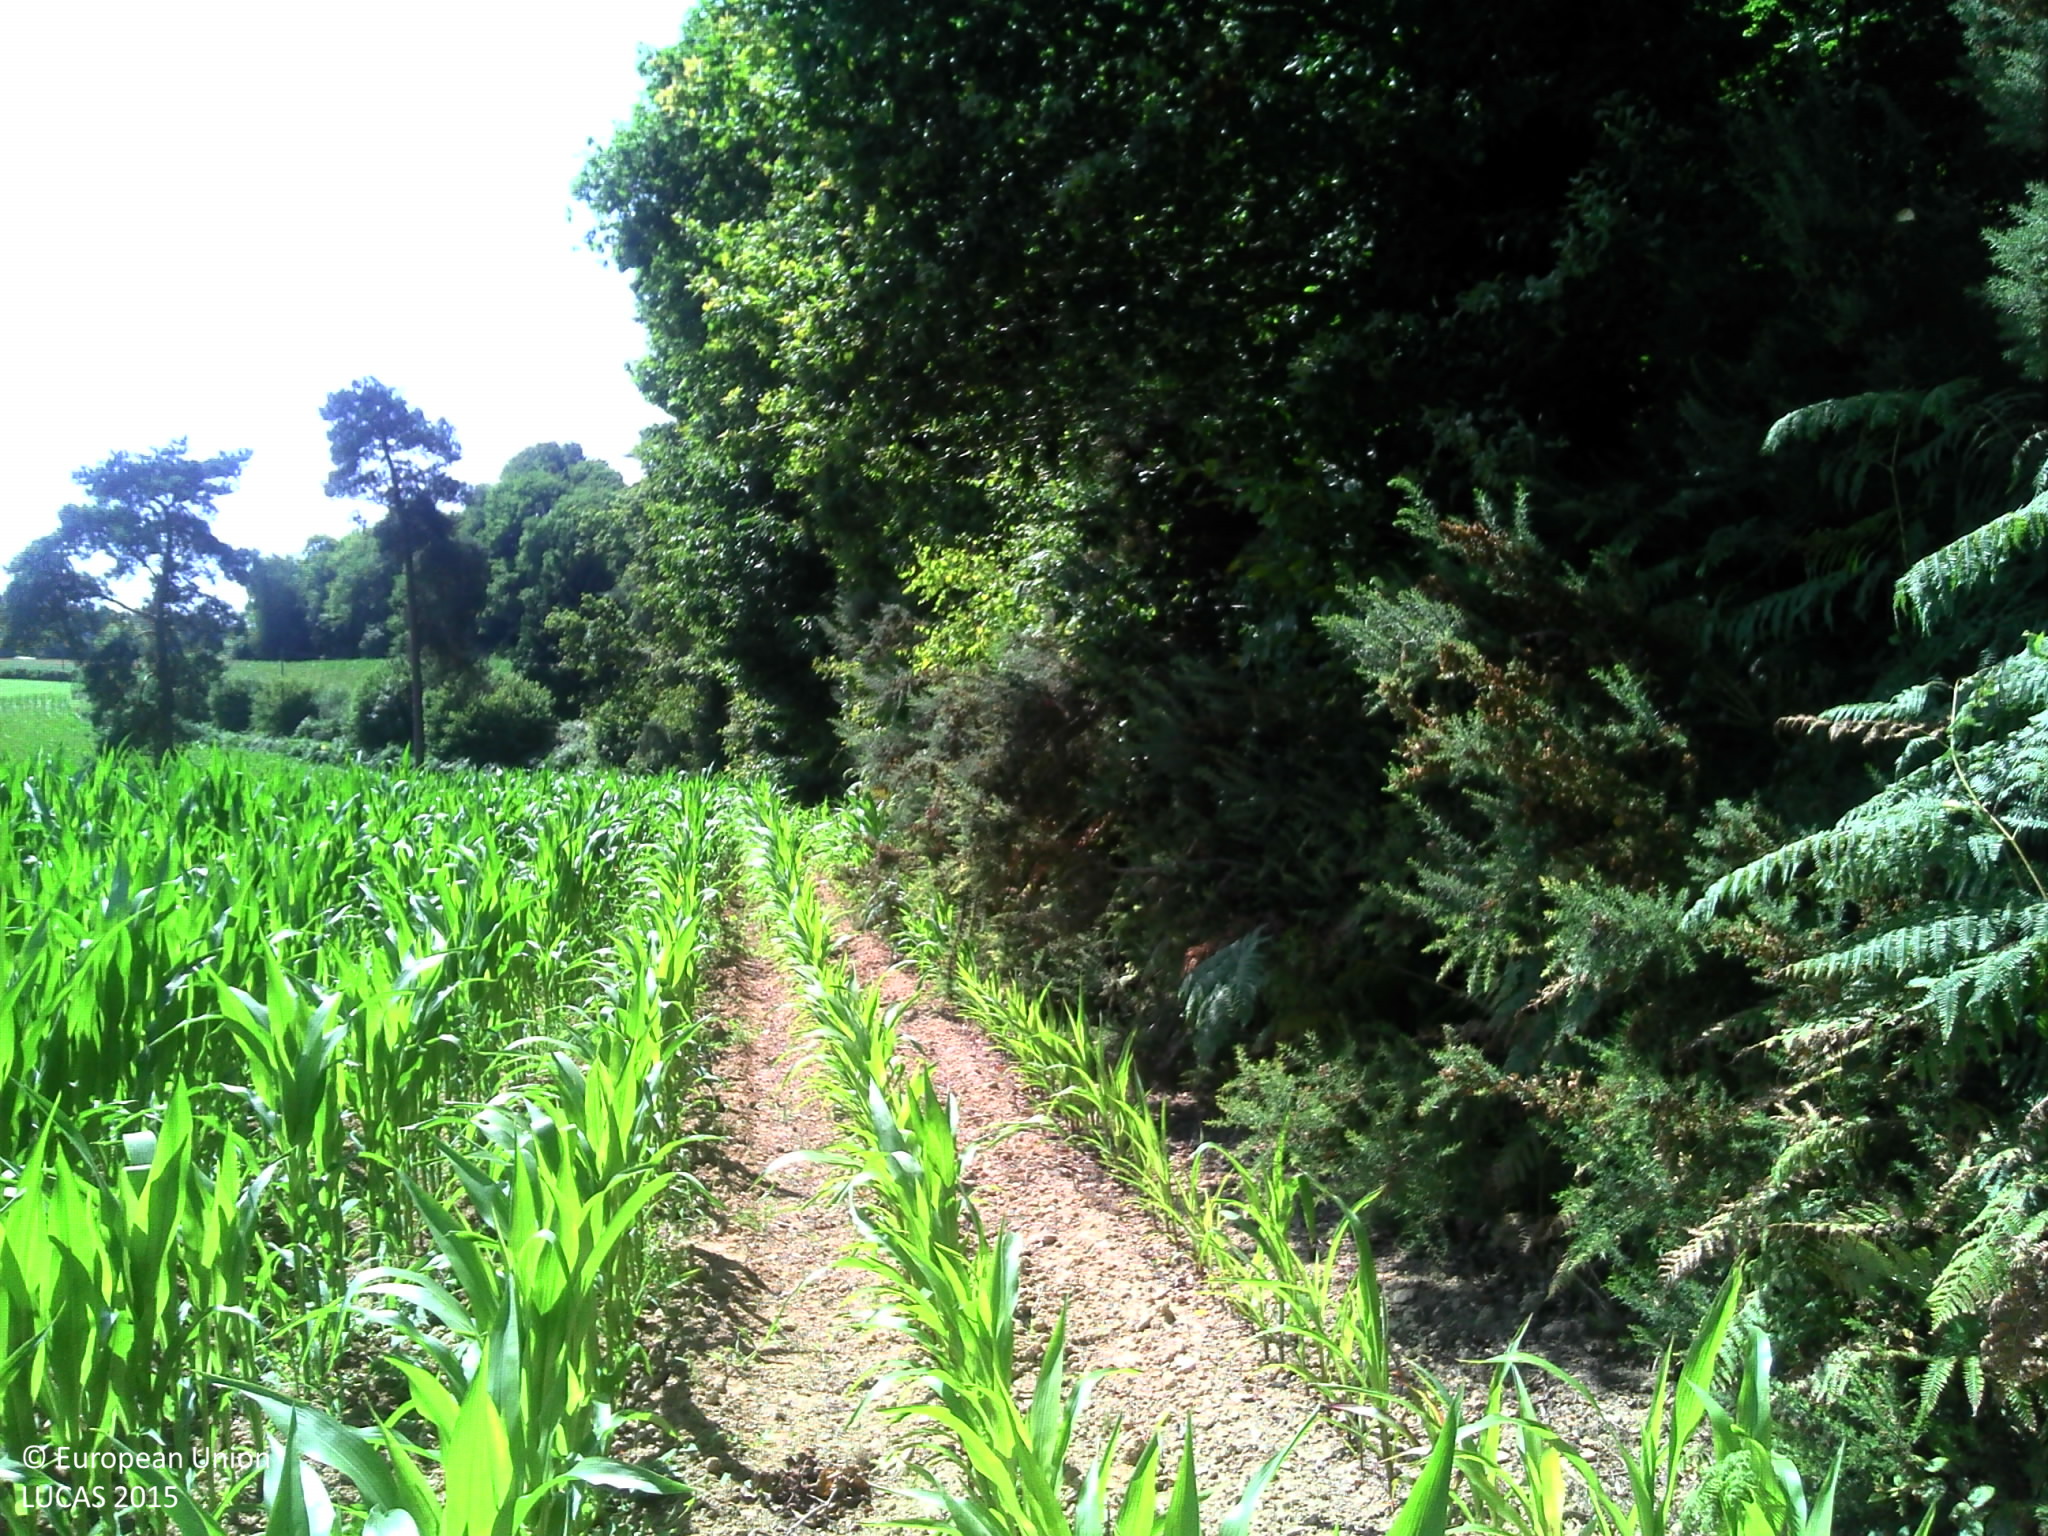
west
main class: Cropland
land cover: Maize
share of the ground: > 75 %
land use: Agriculture (excluding fallow land and kitchen gardens)
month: July
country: FR
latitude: 48.0703
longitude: -2.9922
